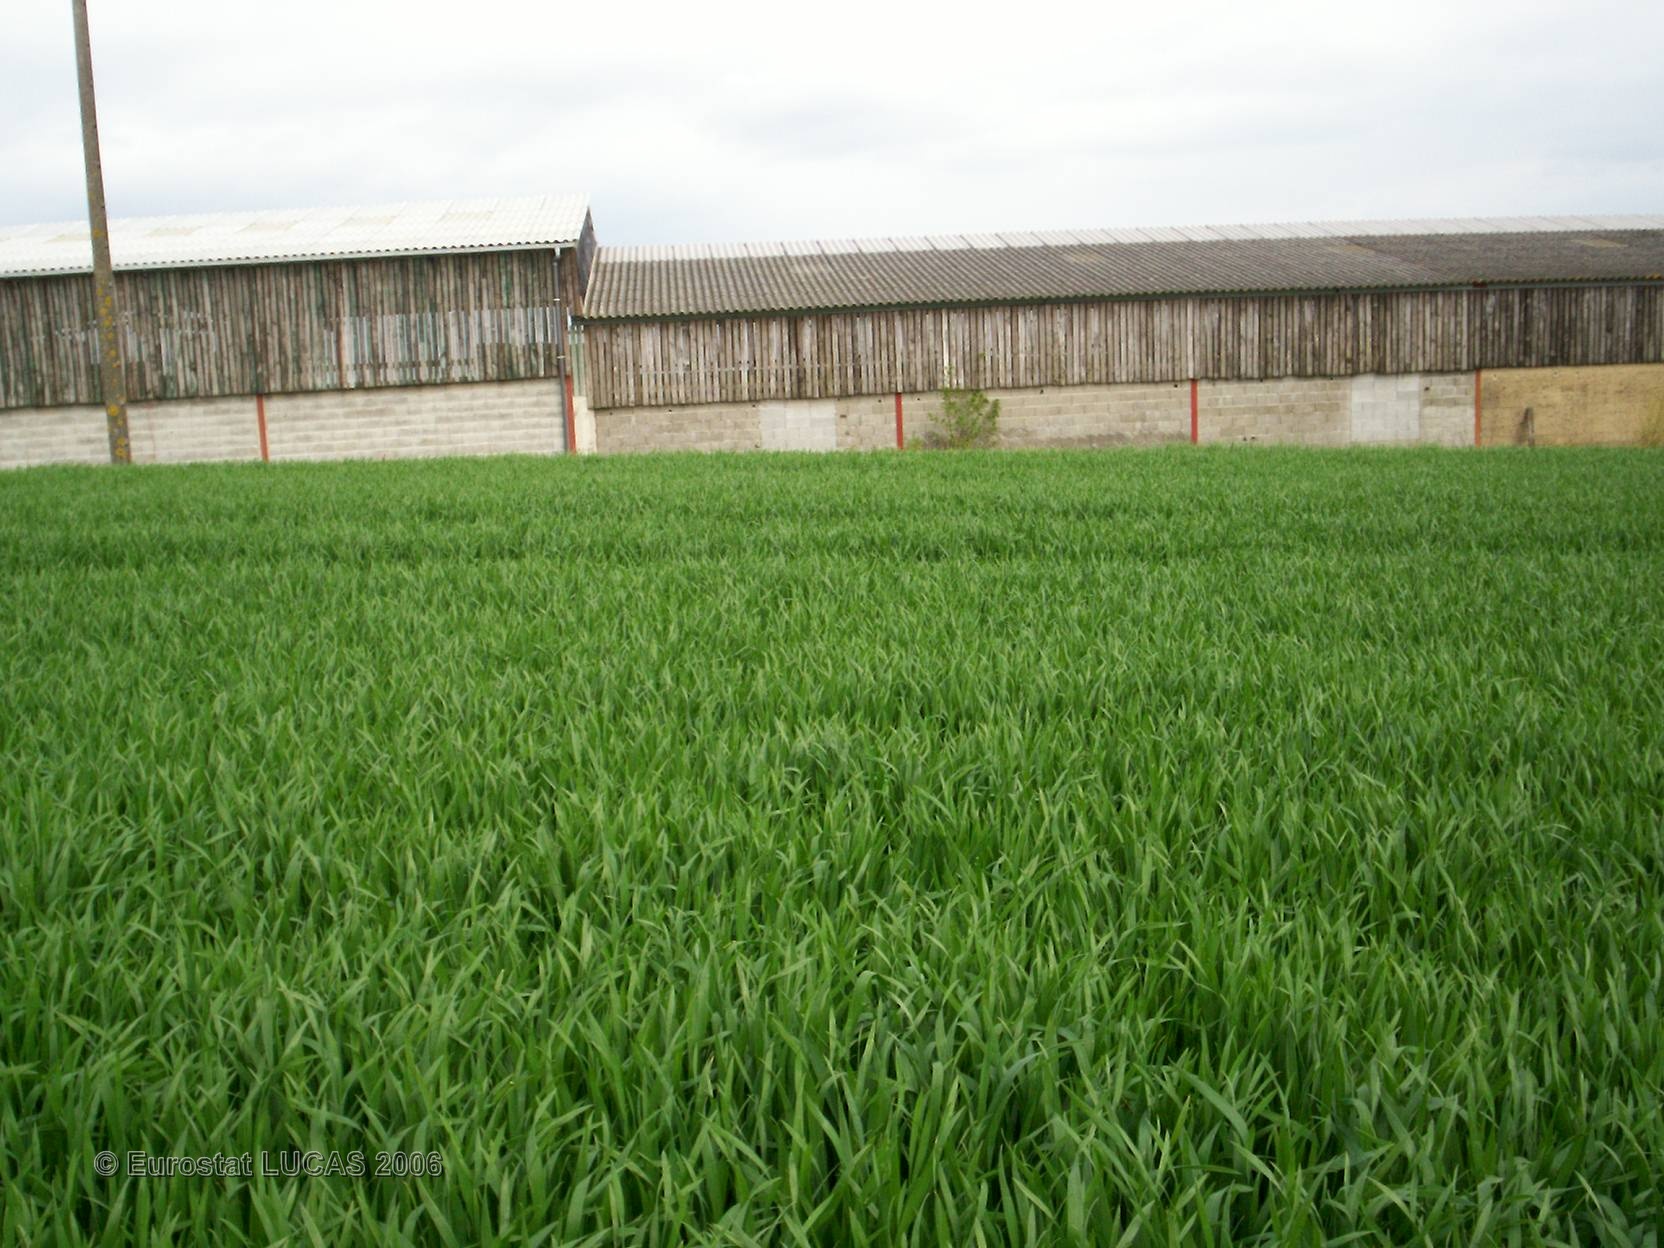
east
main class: Cropland
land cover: Common wheat
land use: Agriculture (excluding fallow land and kitchen gardens)
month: April
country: FR
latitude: 43.6842
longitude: 0.1822
